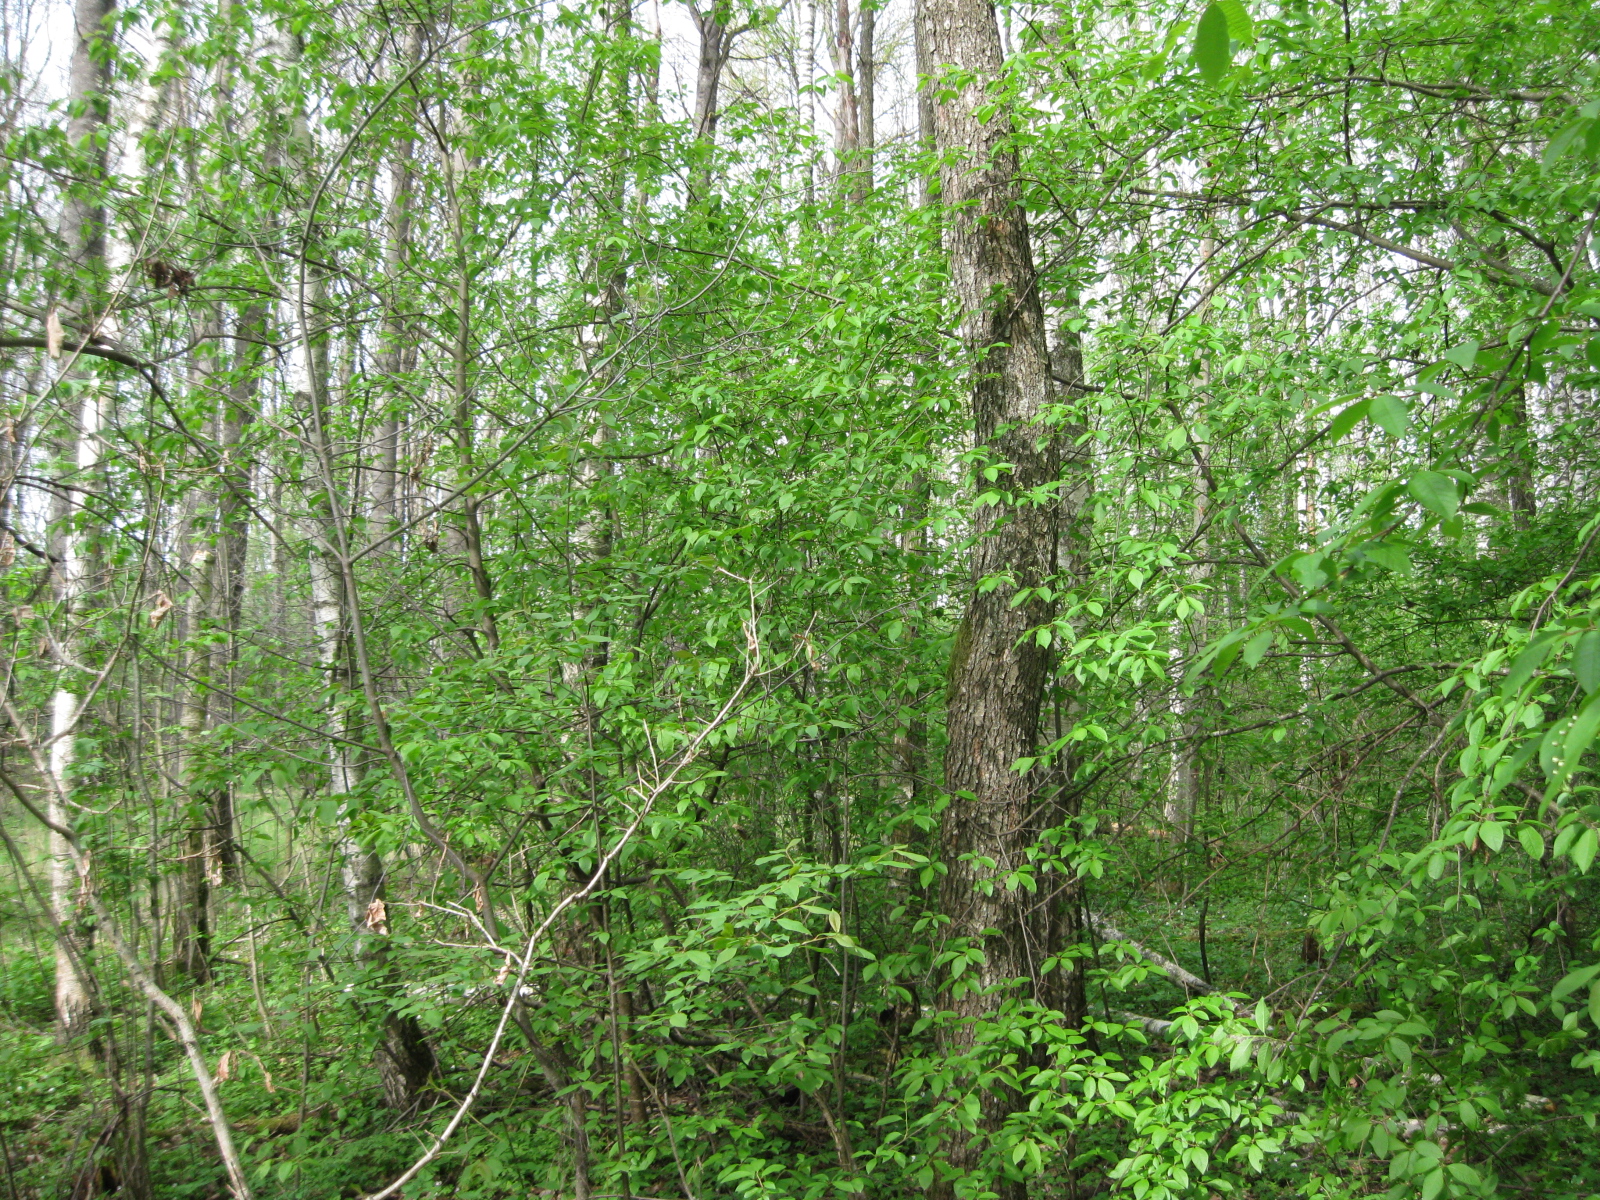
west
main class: Woodland
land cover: Broadleaved woodland
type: non-riverine alder, birch or aspen forest
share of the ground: > 75 %
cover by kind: broadleaved forest trees 85 %, herbaceous plants 10 %, shrubs 5 %
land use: Forestry
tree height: > 5 m
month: May
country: LT
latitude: 56.2536
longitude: 24.5110
